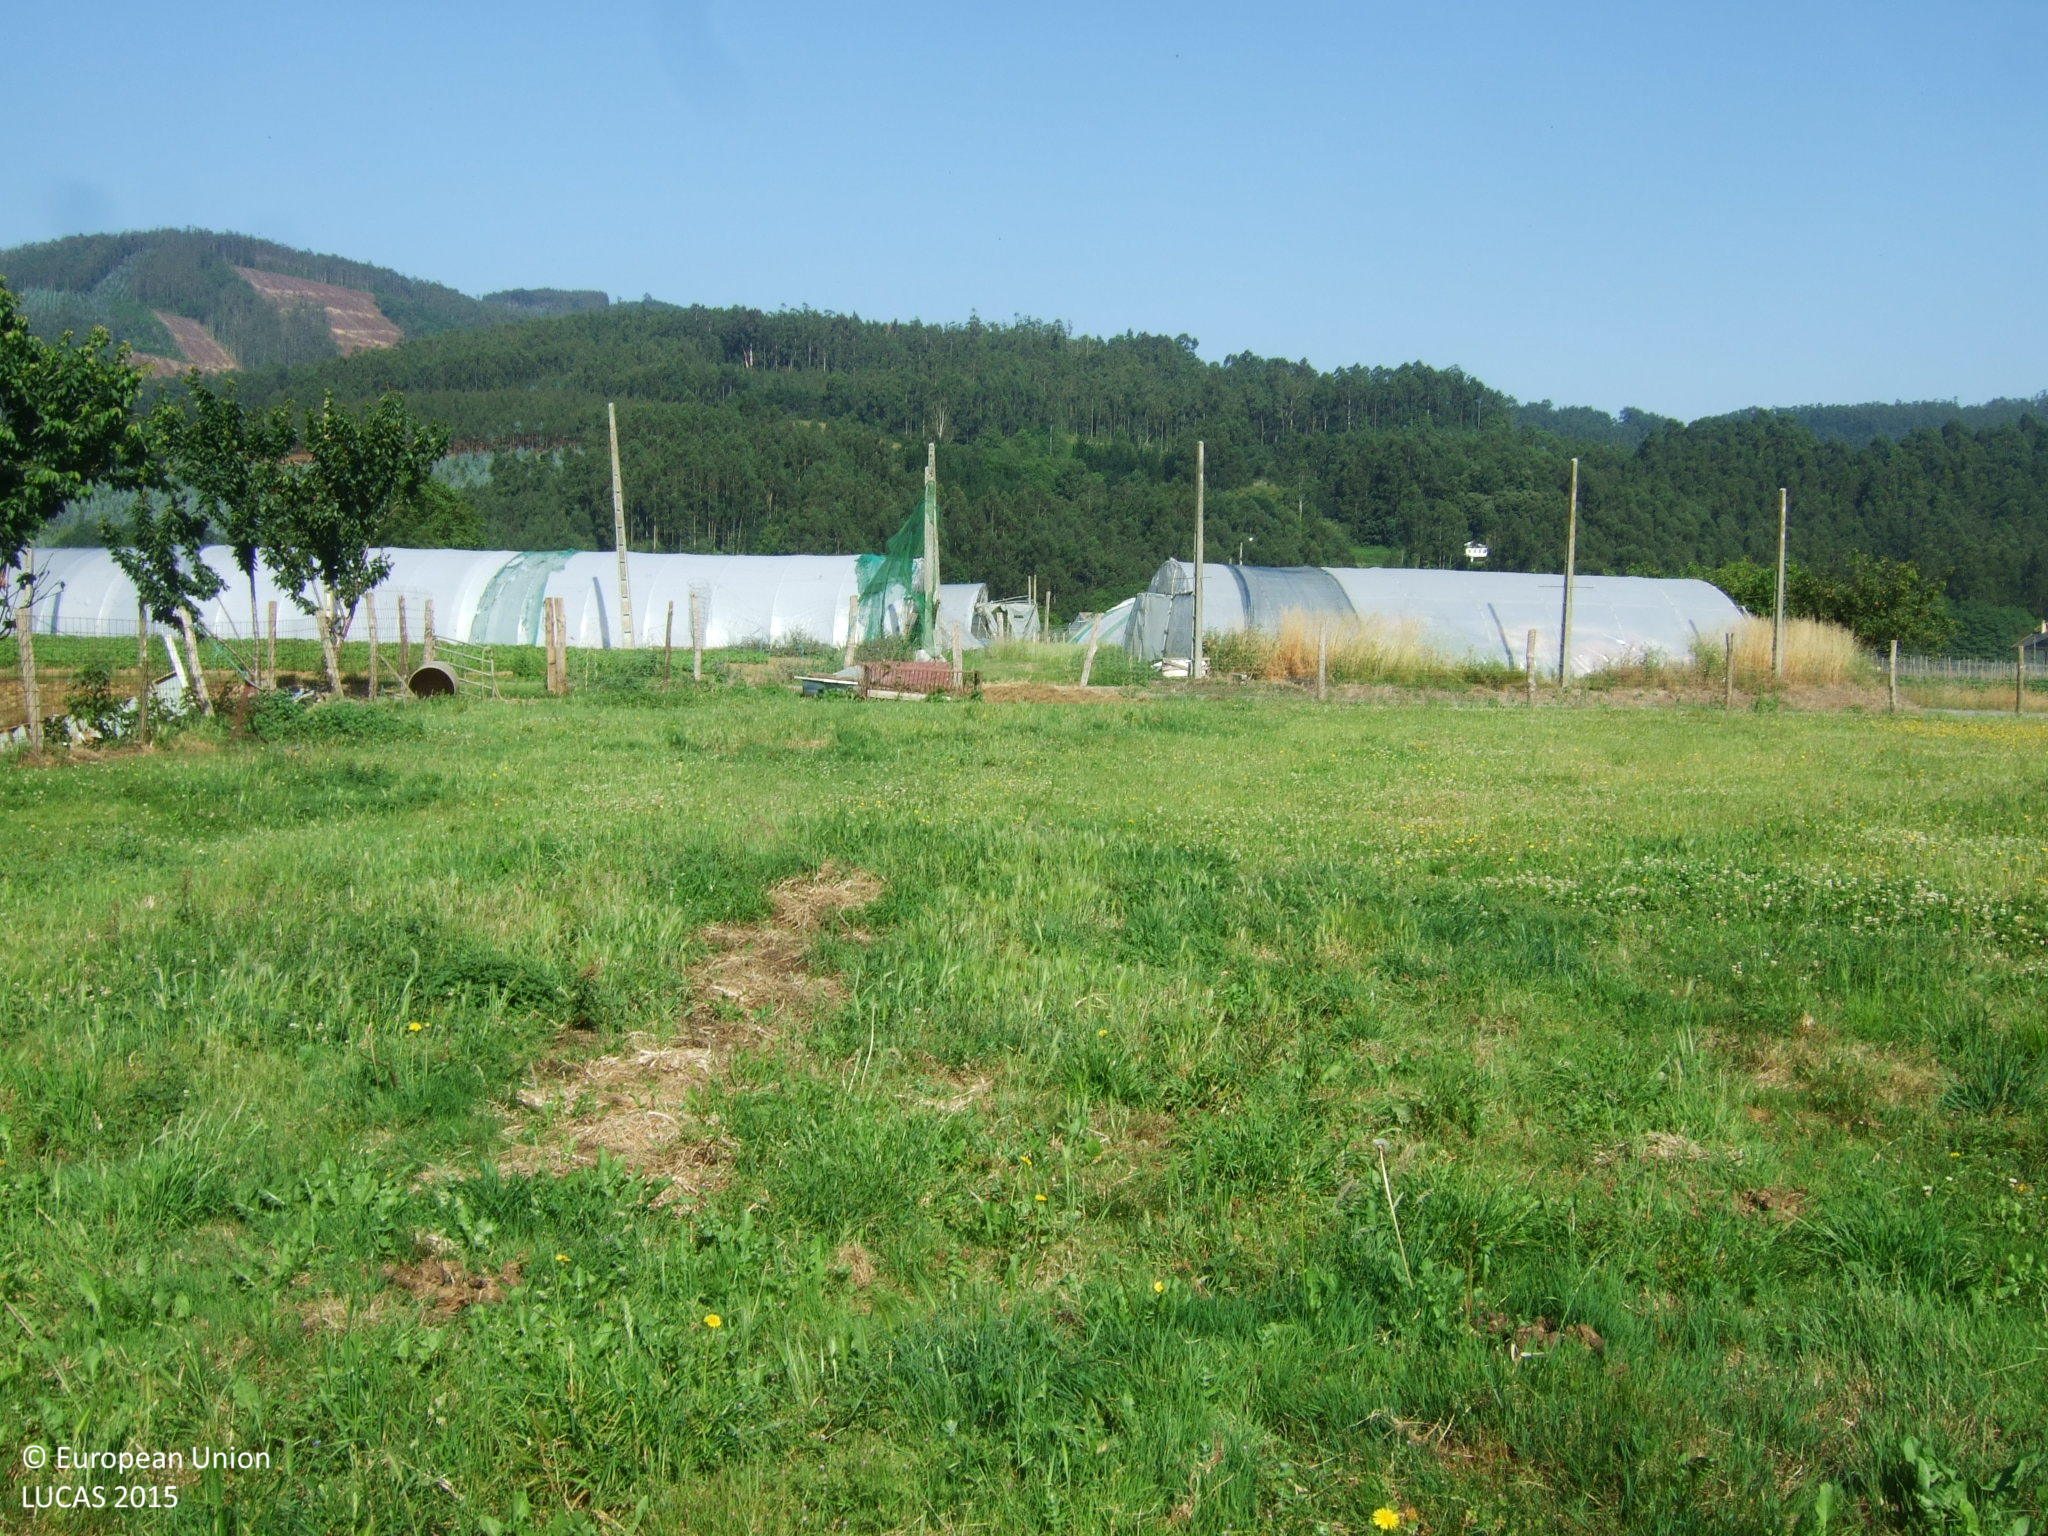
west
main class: Grassland
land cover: Grassland without tree/shrub cover
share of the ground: > 75 %
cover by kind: herbaceous plants 100 %
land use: Agriculture (excluding fallow land and kitchen gardens)
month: June
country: ES
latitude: 43.4389
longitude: -7.2855
